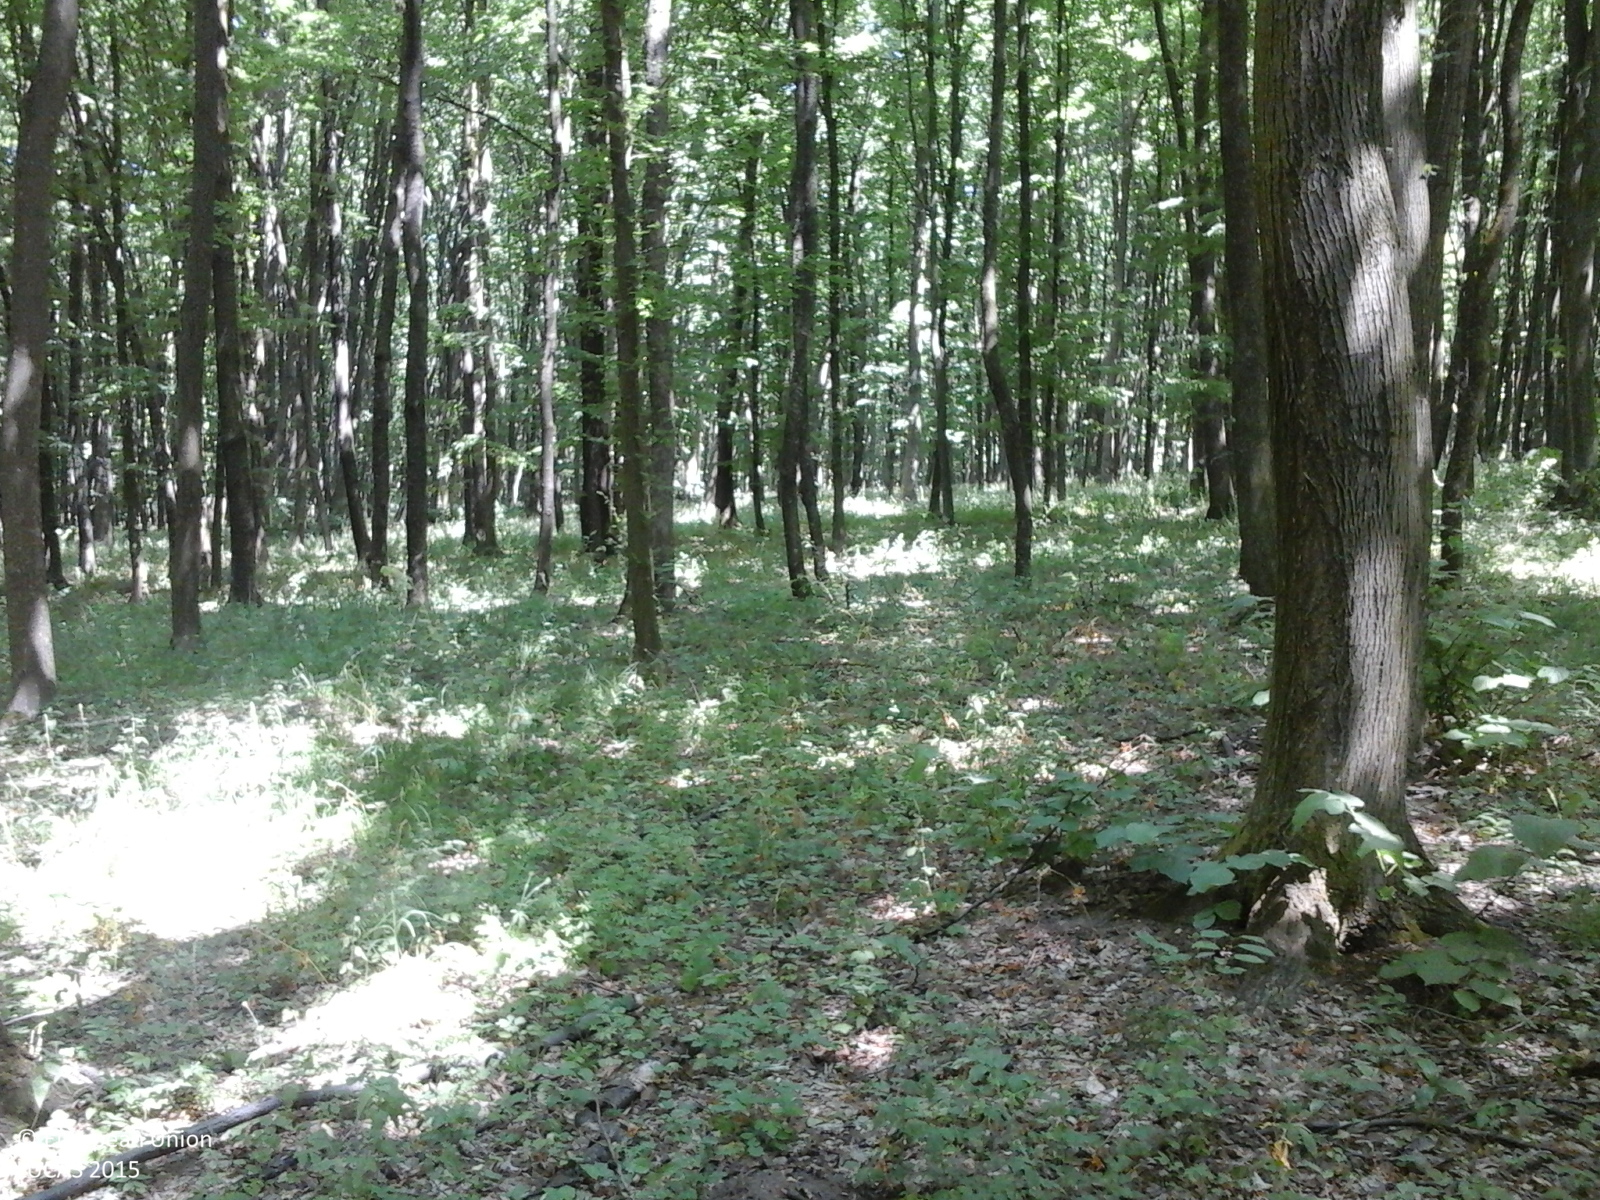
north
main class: Woodland
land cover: Broadleaved woodland
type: beech forest
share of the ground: > 75 %
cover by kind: broadleaved forest trees 100 %
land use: Forestry
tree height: > 5 m
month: June
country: RO
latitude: 46.6913
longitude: 26.9780
